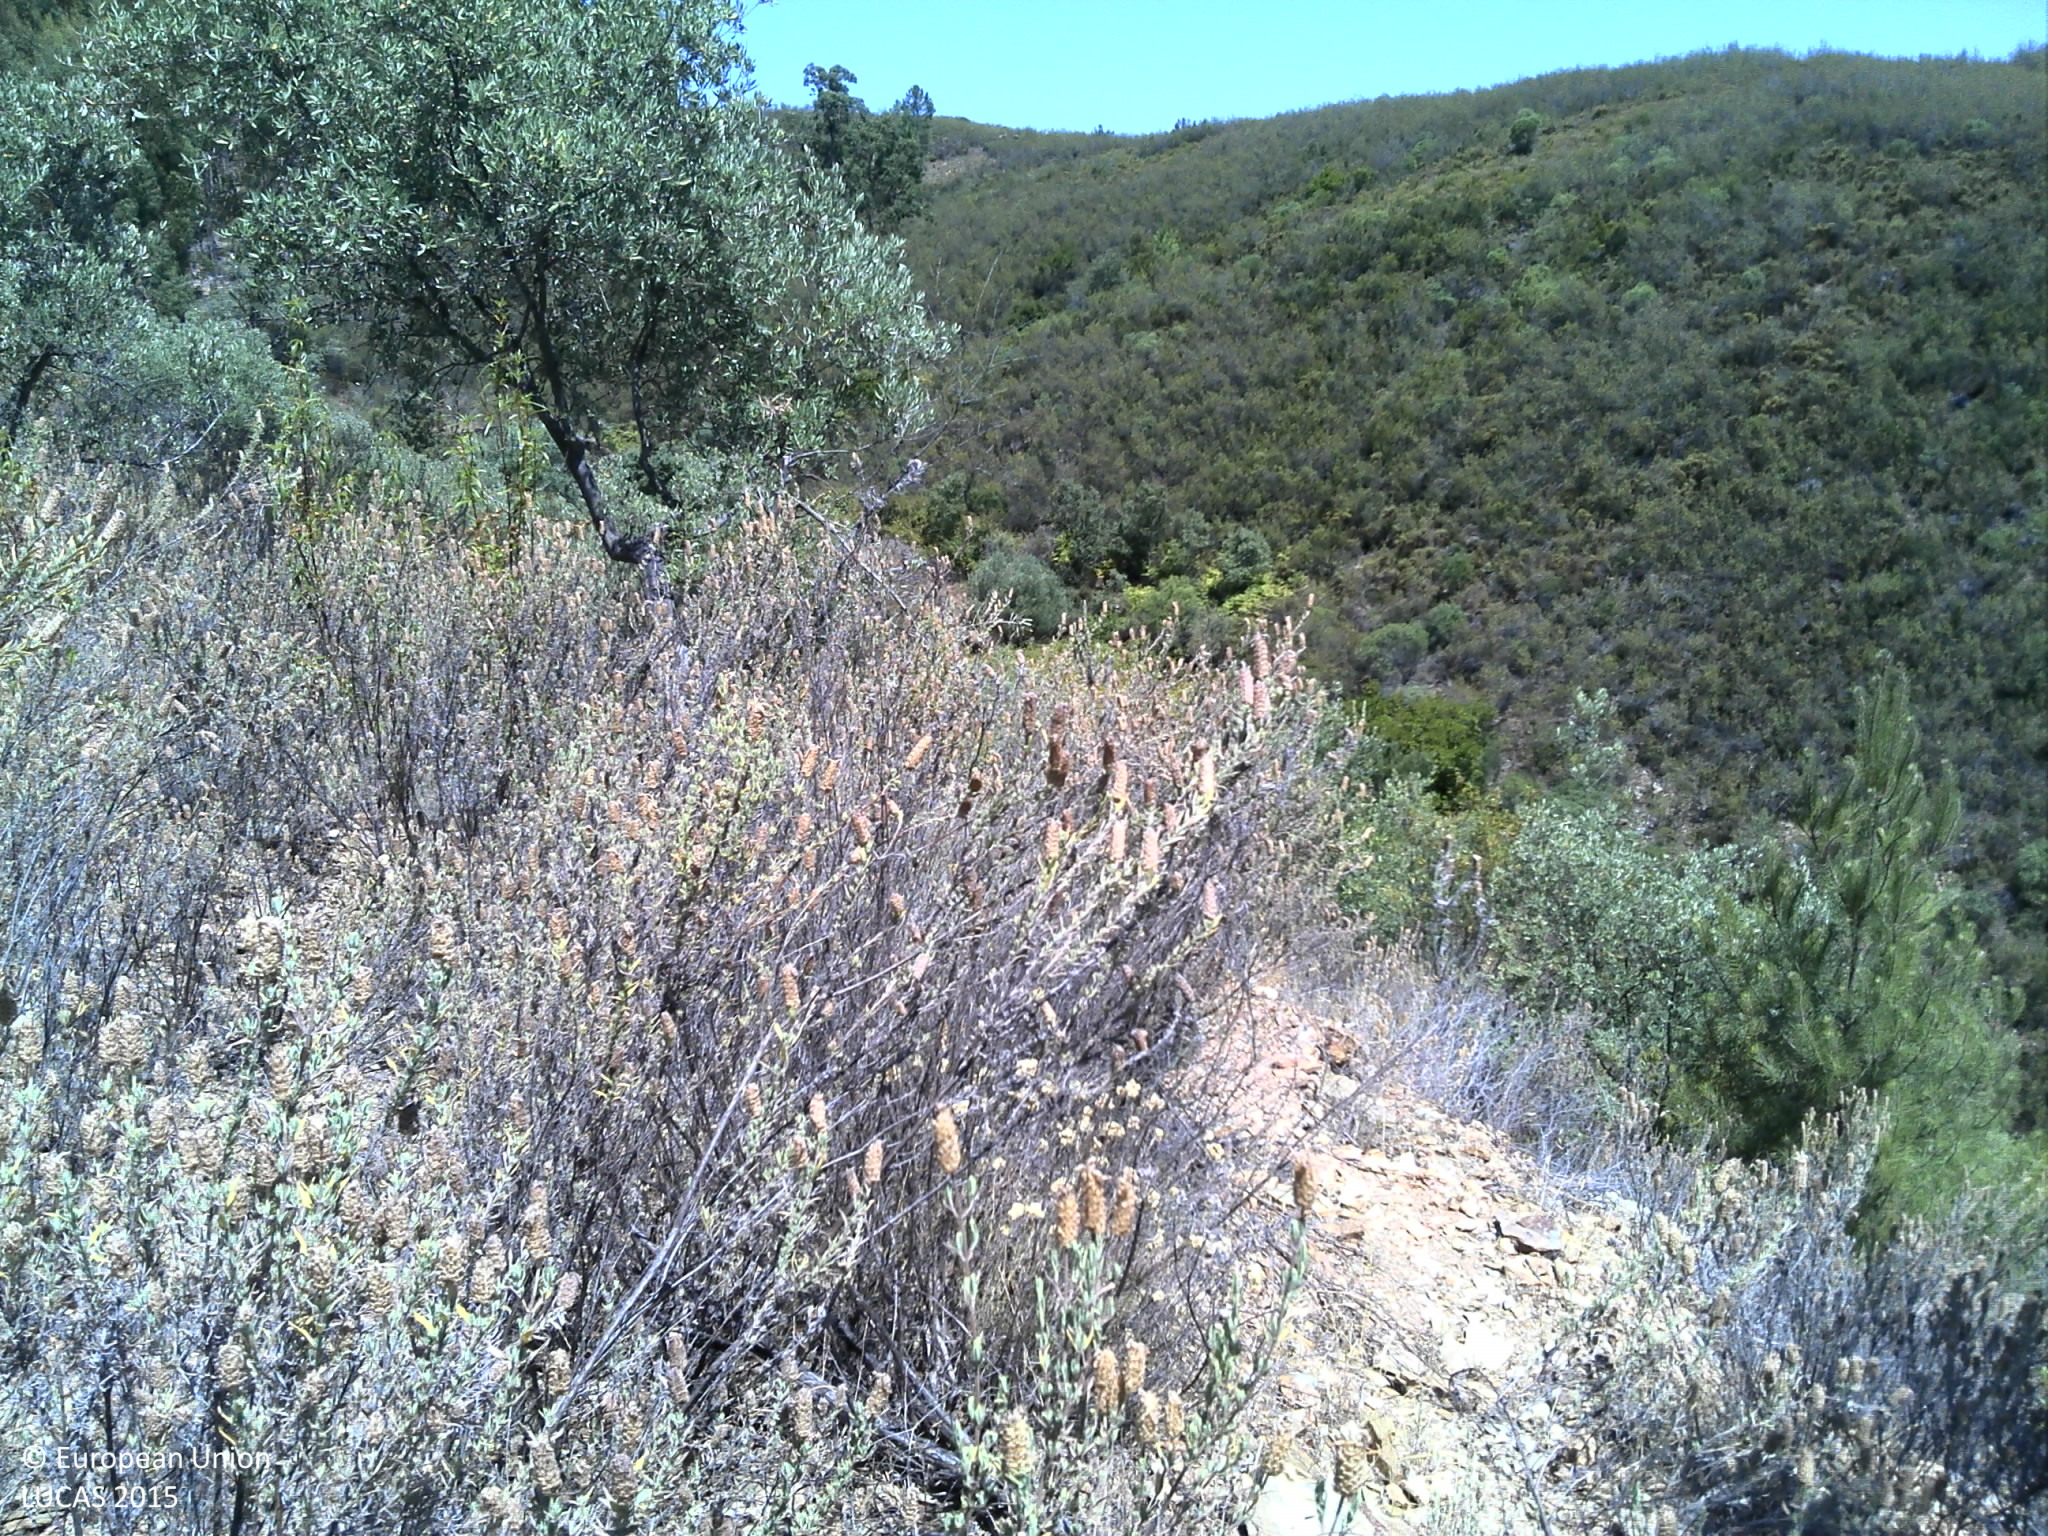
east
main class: Cropland
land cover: Olive groves
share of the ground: < 10 %
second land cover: Shrubland without tree cover
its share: 50 - 75 %
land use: Abandoned areas
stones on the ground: 10 - 25 %
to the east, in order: Olive groves; Shrubland without tree cover; Olive groves; Dry stone walls; Olive groves; Dry stone walls; Olive groves; Shrubland with sparse tree cover; Dry stone walls; Grassland with sparse tree/shrub cover; Dry stone walls; Shrubland with sparse tree cover
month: July
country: PT
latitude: 39.6829
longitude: -7.6718
